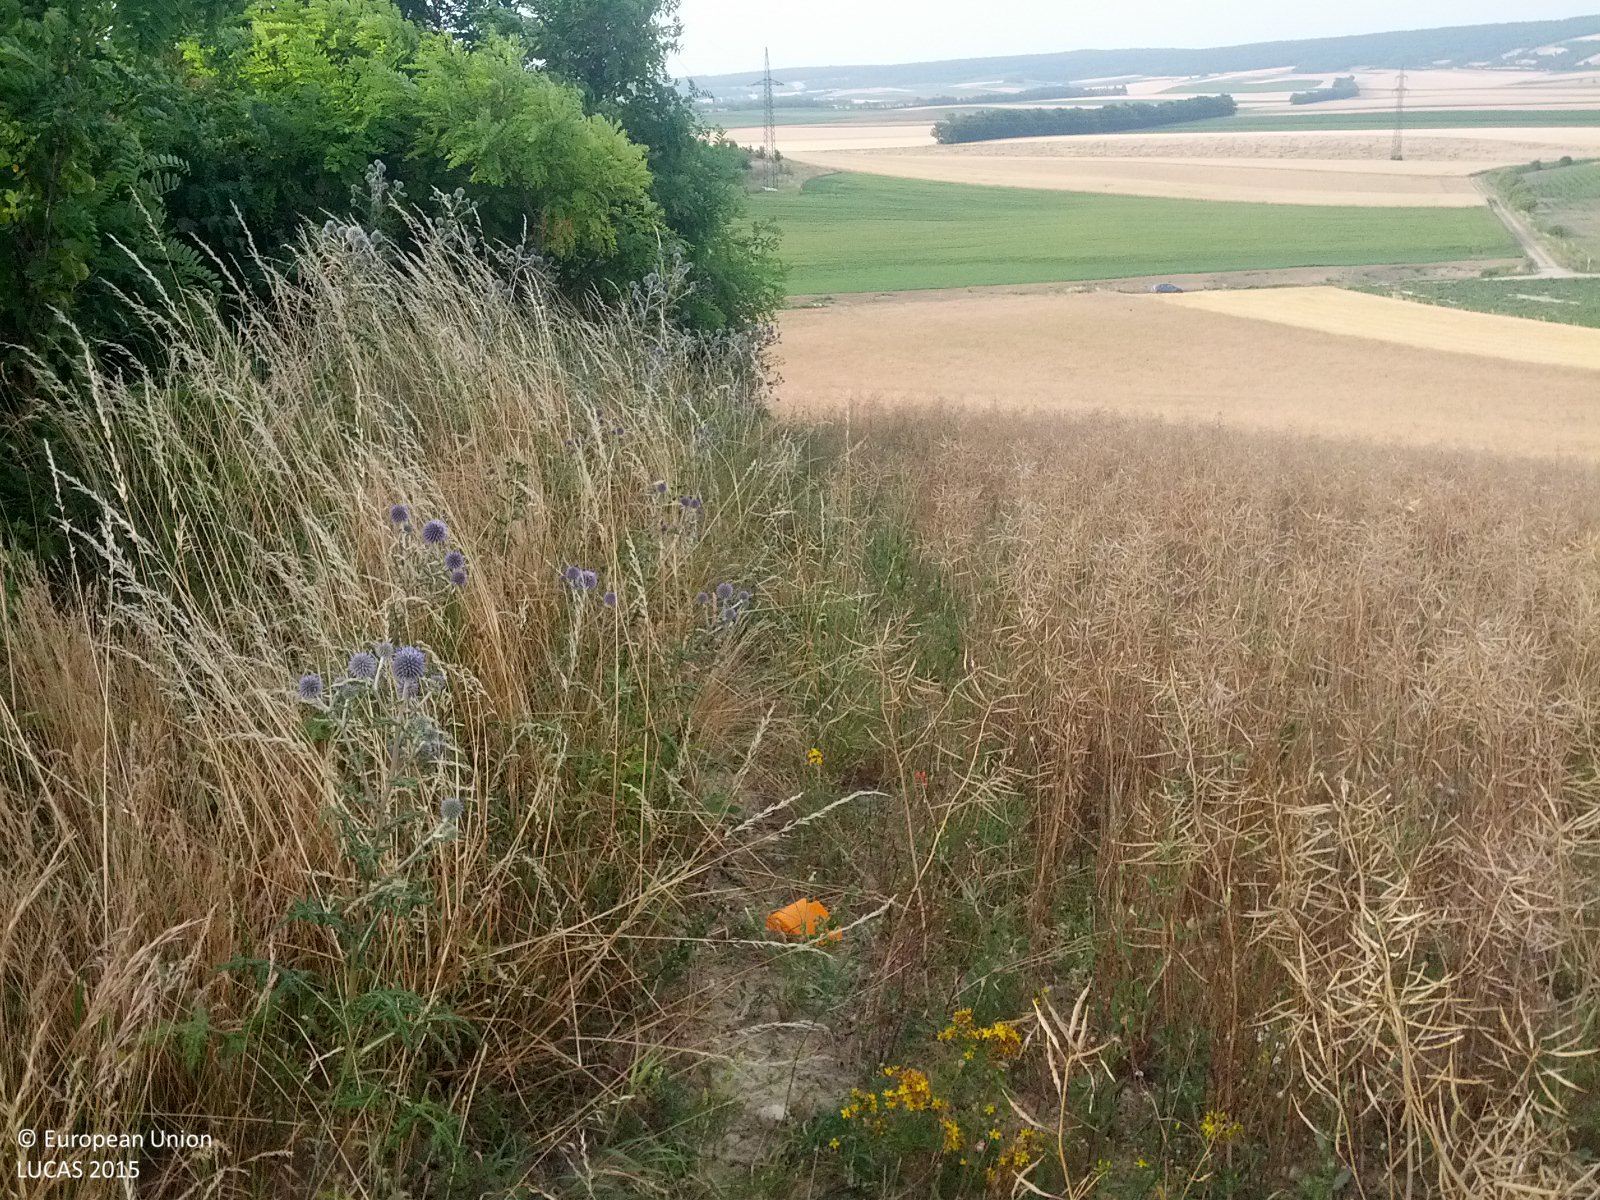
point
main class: Shrubland
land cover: Shrubland without tree cover
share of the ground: 50 - 75 %
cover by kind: shrubs 60 %, herbaceous plants 40 %
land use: Semi-natural and natural areas not in use
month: July
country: AT
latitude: 48.6808
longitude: 16.5122
